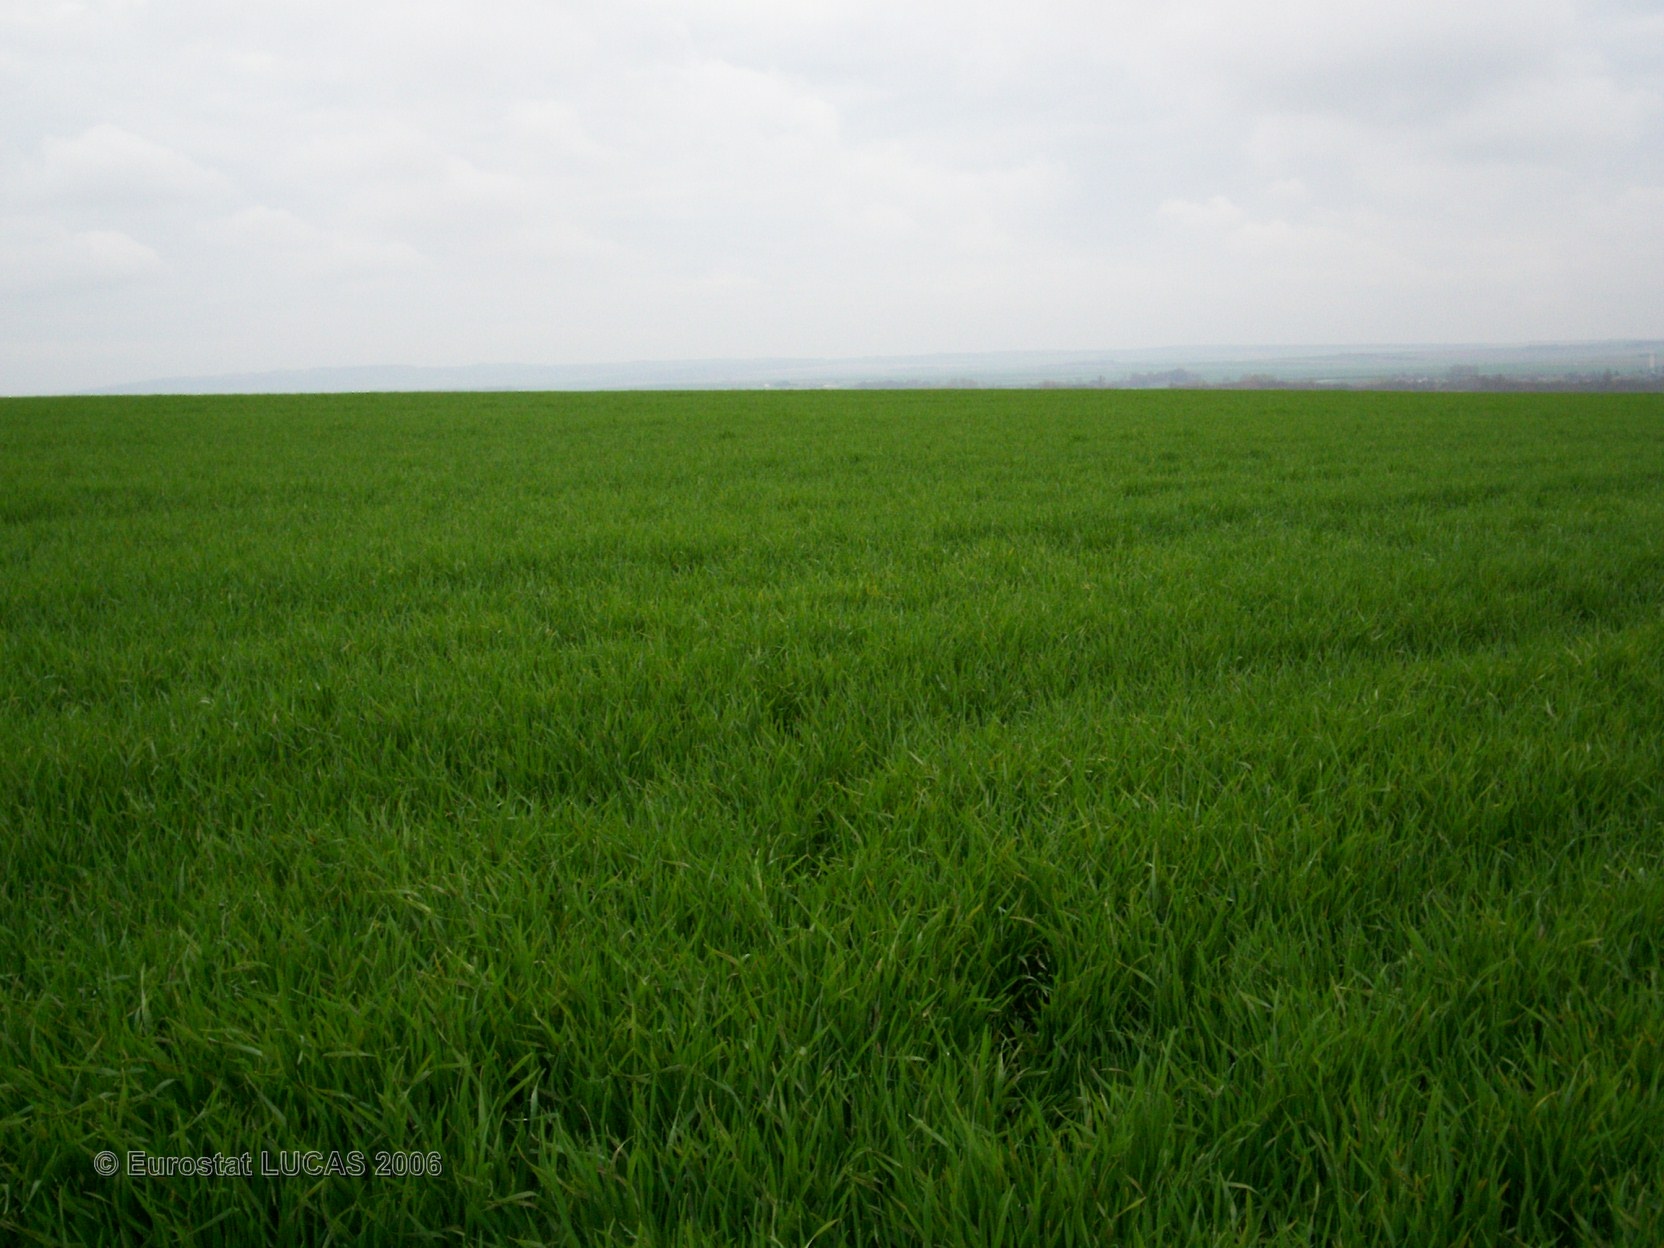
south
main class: Cropland
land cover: Barley
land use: Agriculture (excluding fallow land and kitchen gardens)
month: April
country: FR
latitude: 48.4201
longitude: 3.9828
